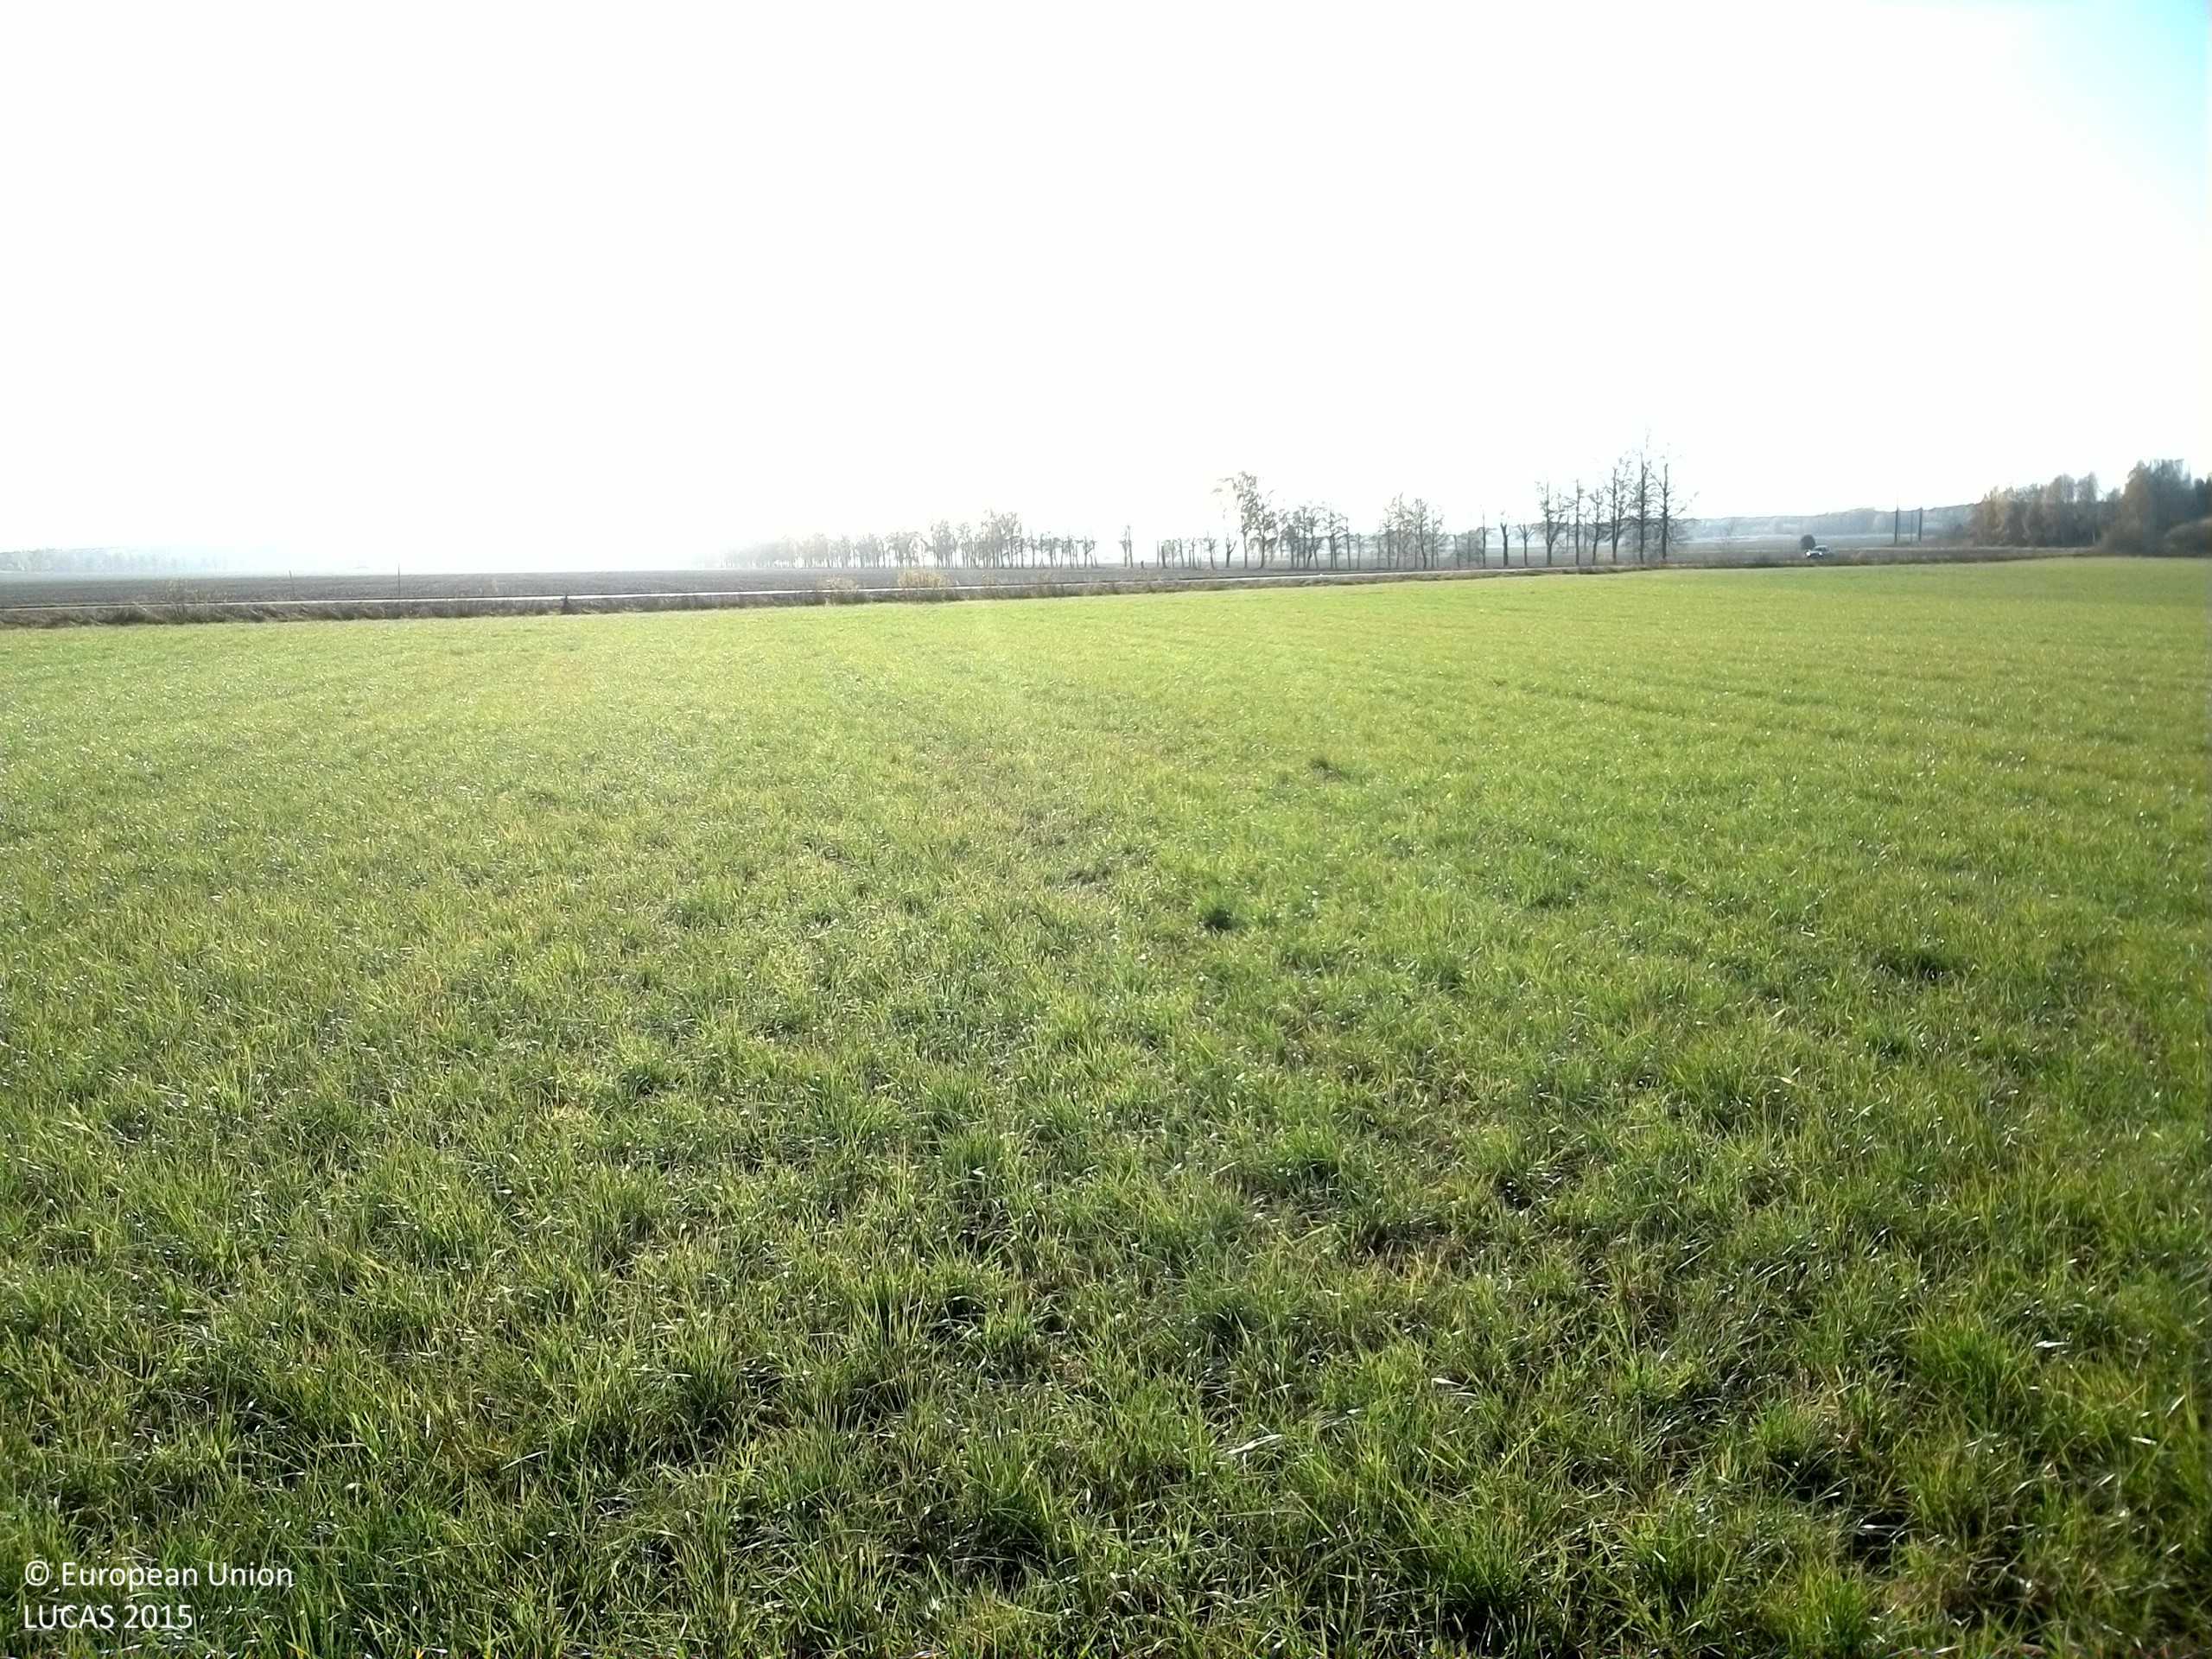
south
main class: Cropland
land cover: Temporary grasslands
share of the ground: > 75 %
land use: Agriculture (excluding fallow land and kitchen gardens)
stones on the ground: < 10 %
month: October
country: SE
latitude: 59.8124
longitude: 16.5347
